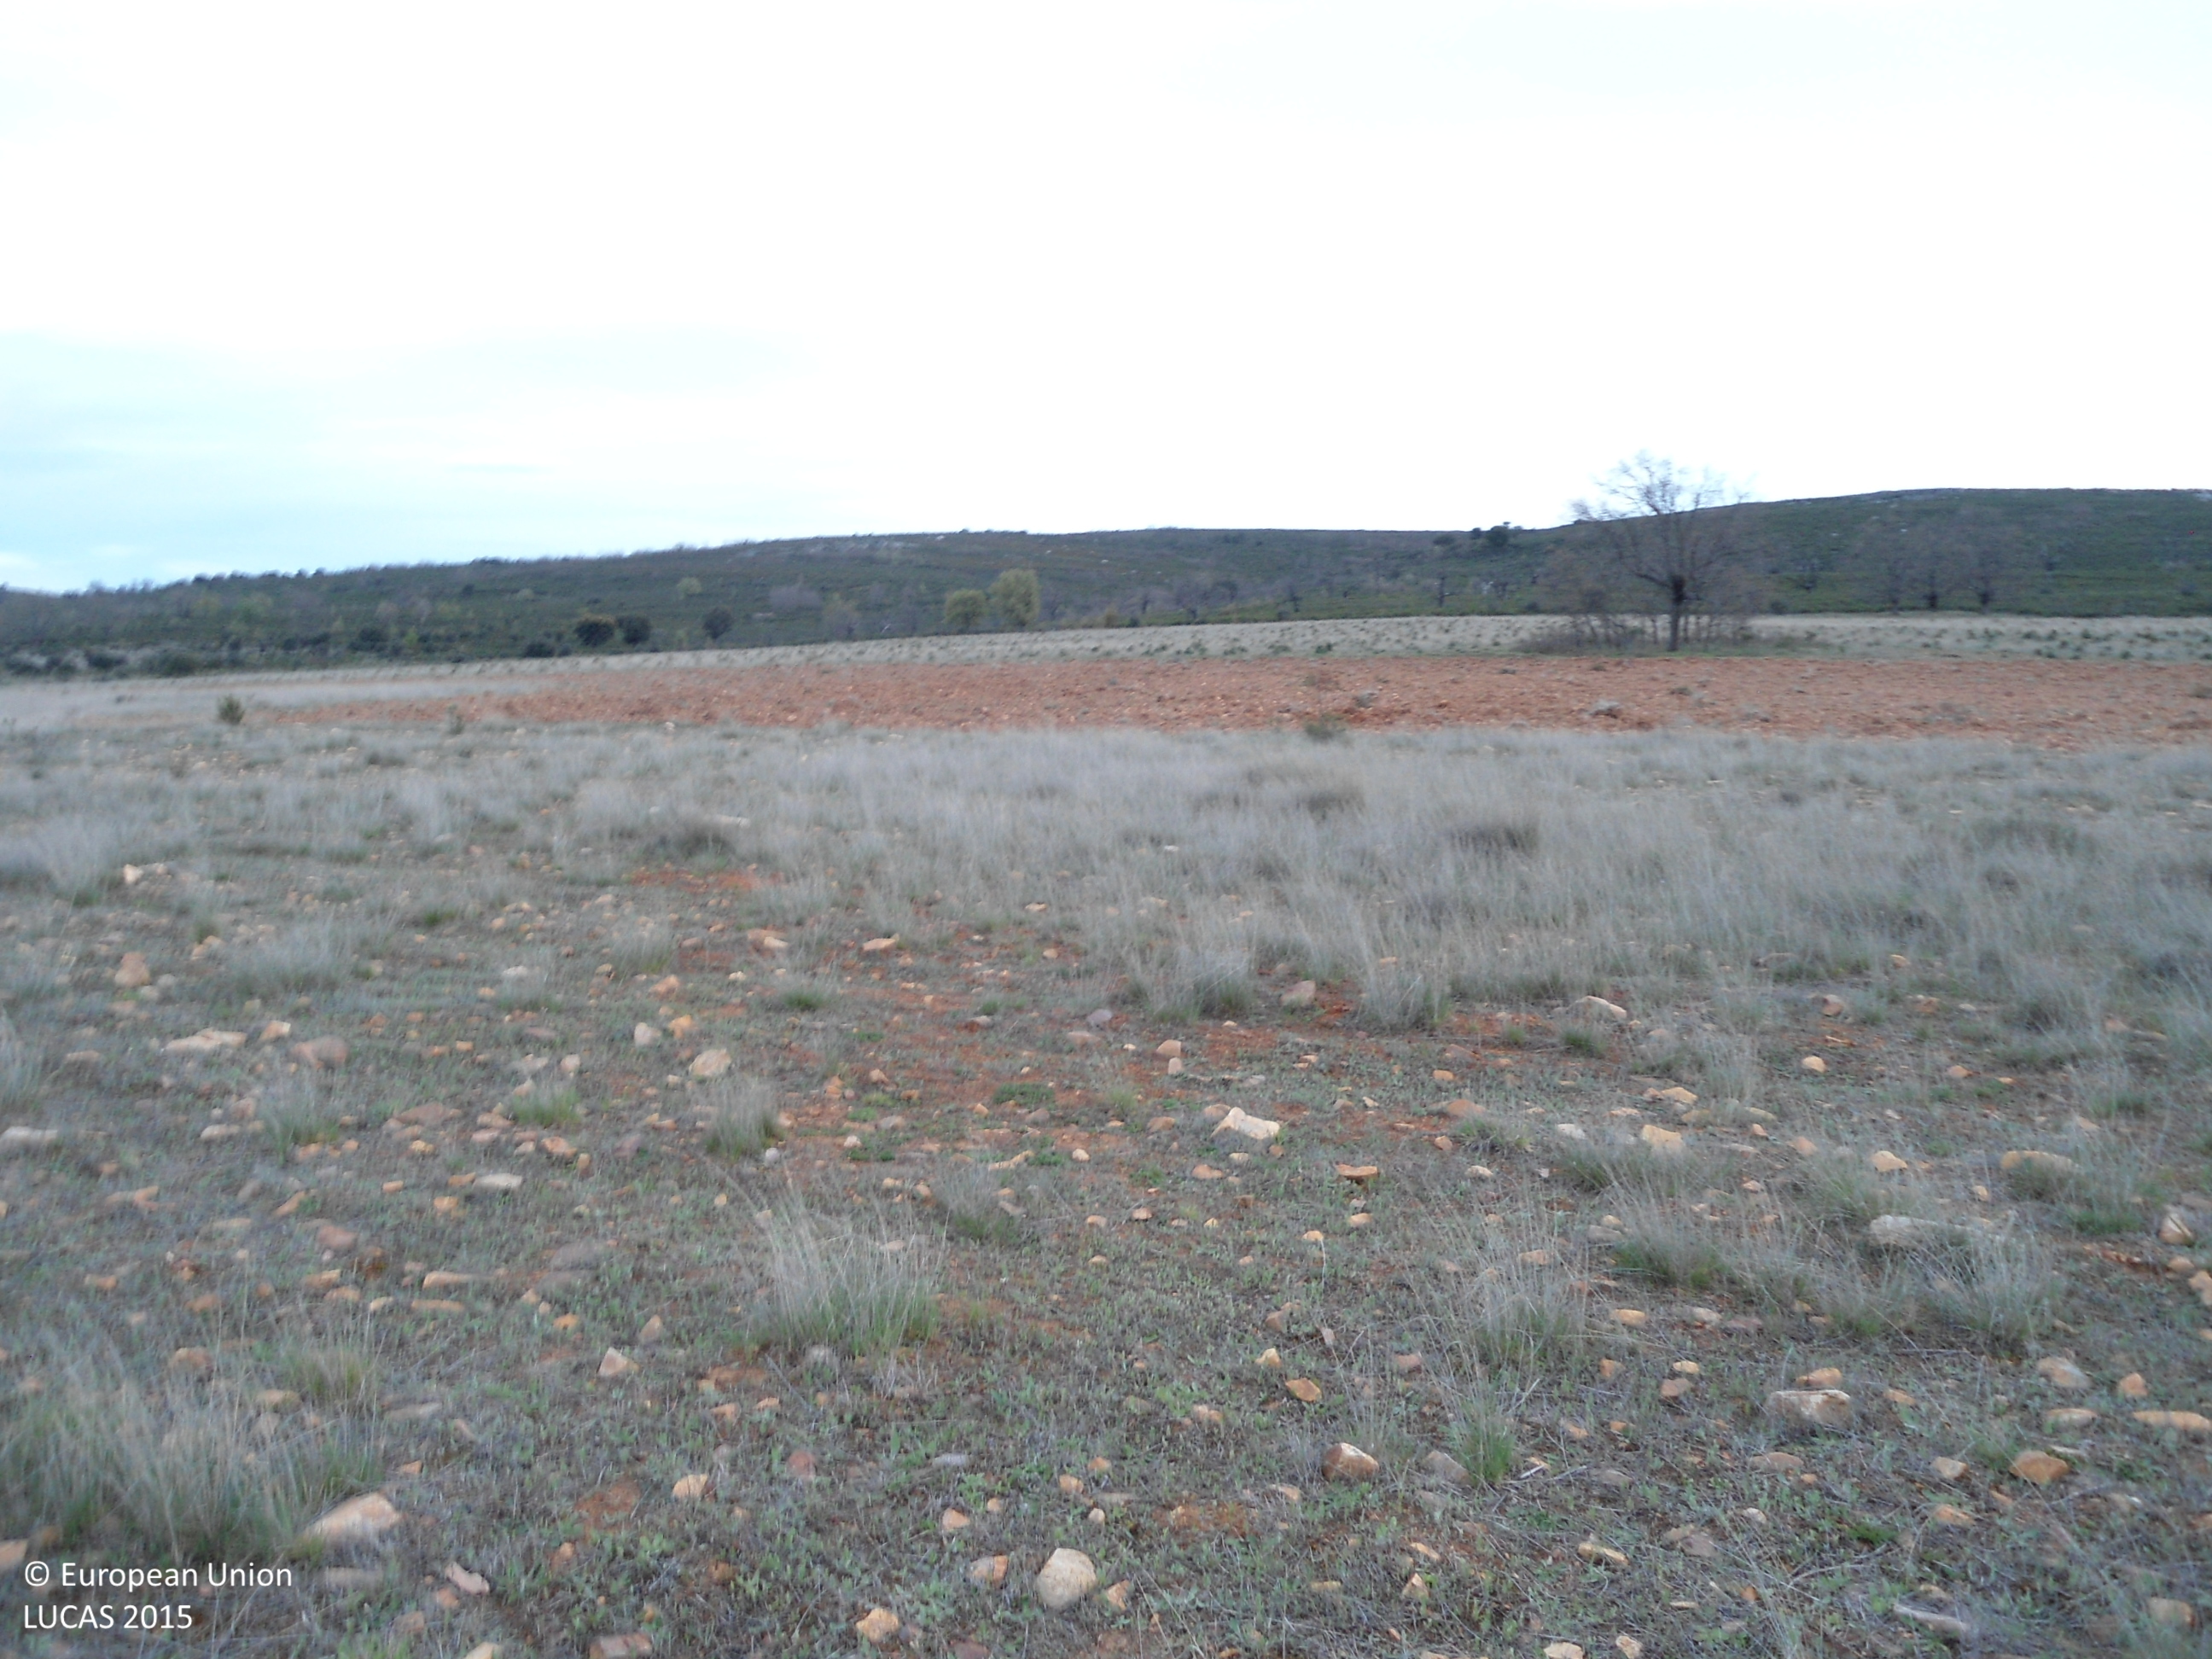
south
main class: Grassland
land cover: Spontaneously vegetated surfaces
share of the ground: > 75 %
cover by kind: herbaceous plants 100 %
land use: Agriculture (excluding fallow land and kitchen gardens)
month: April
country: ES
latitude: 41.7862
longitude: -5.9414
